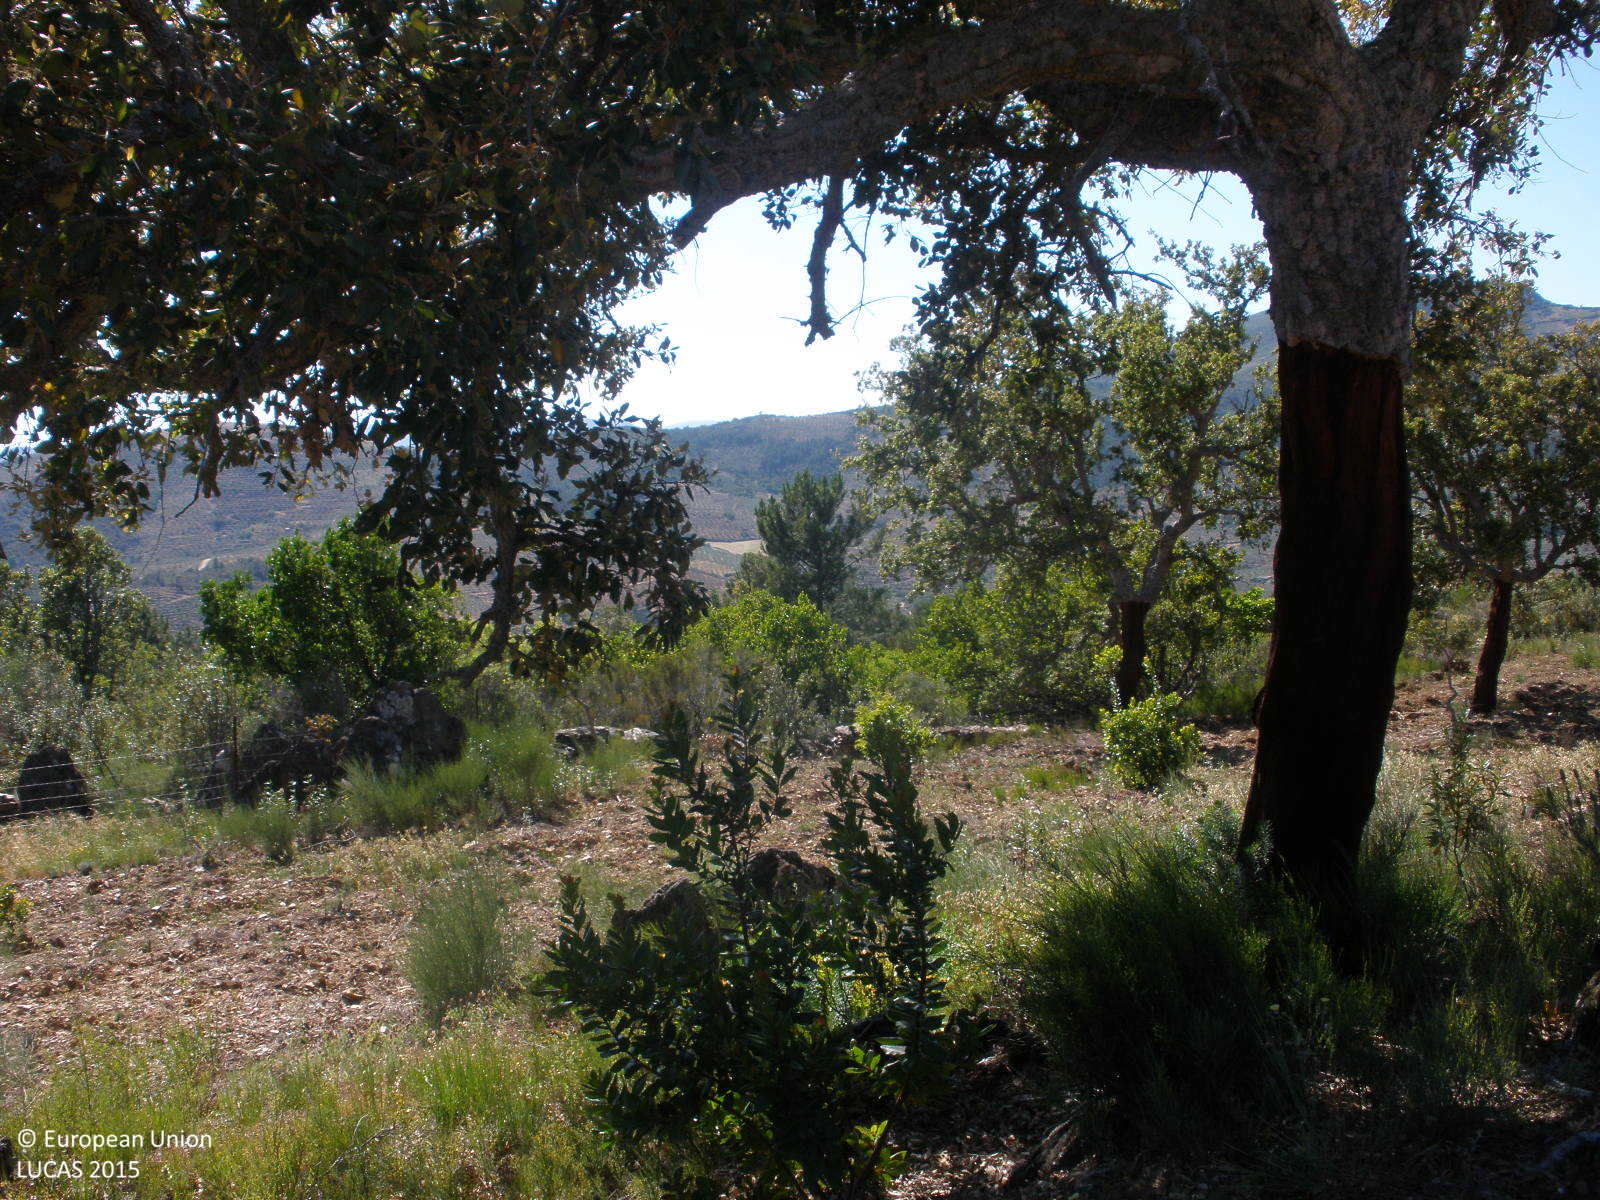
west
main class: Woodland
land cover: Broadleaved woodland
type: broadleaved evergreen forest
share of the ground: > 75 %
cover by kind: herbaceous plants 50 %, broadleaved forest trees 40 %, shrubs 10 %
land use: Forestry
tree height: < 5 m
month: May
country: ES
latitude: 40.2613
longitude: -6.2699
